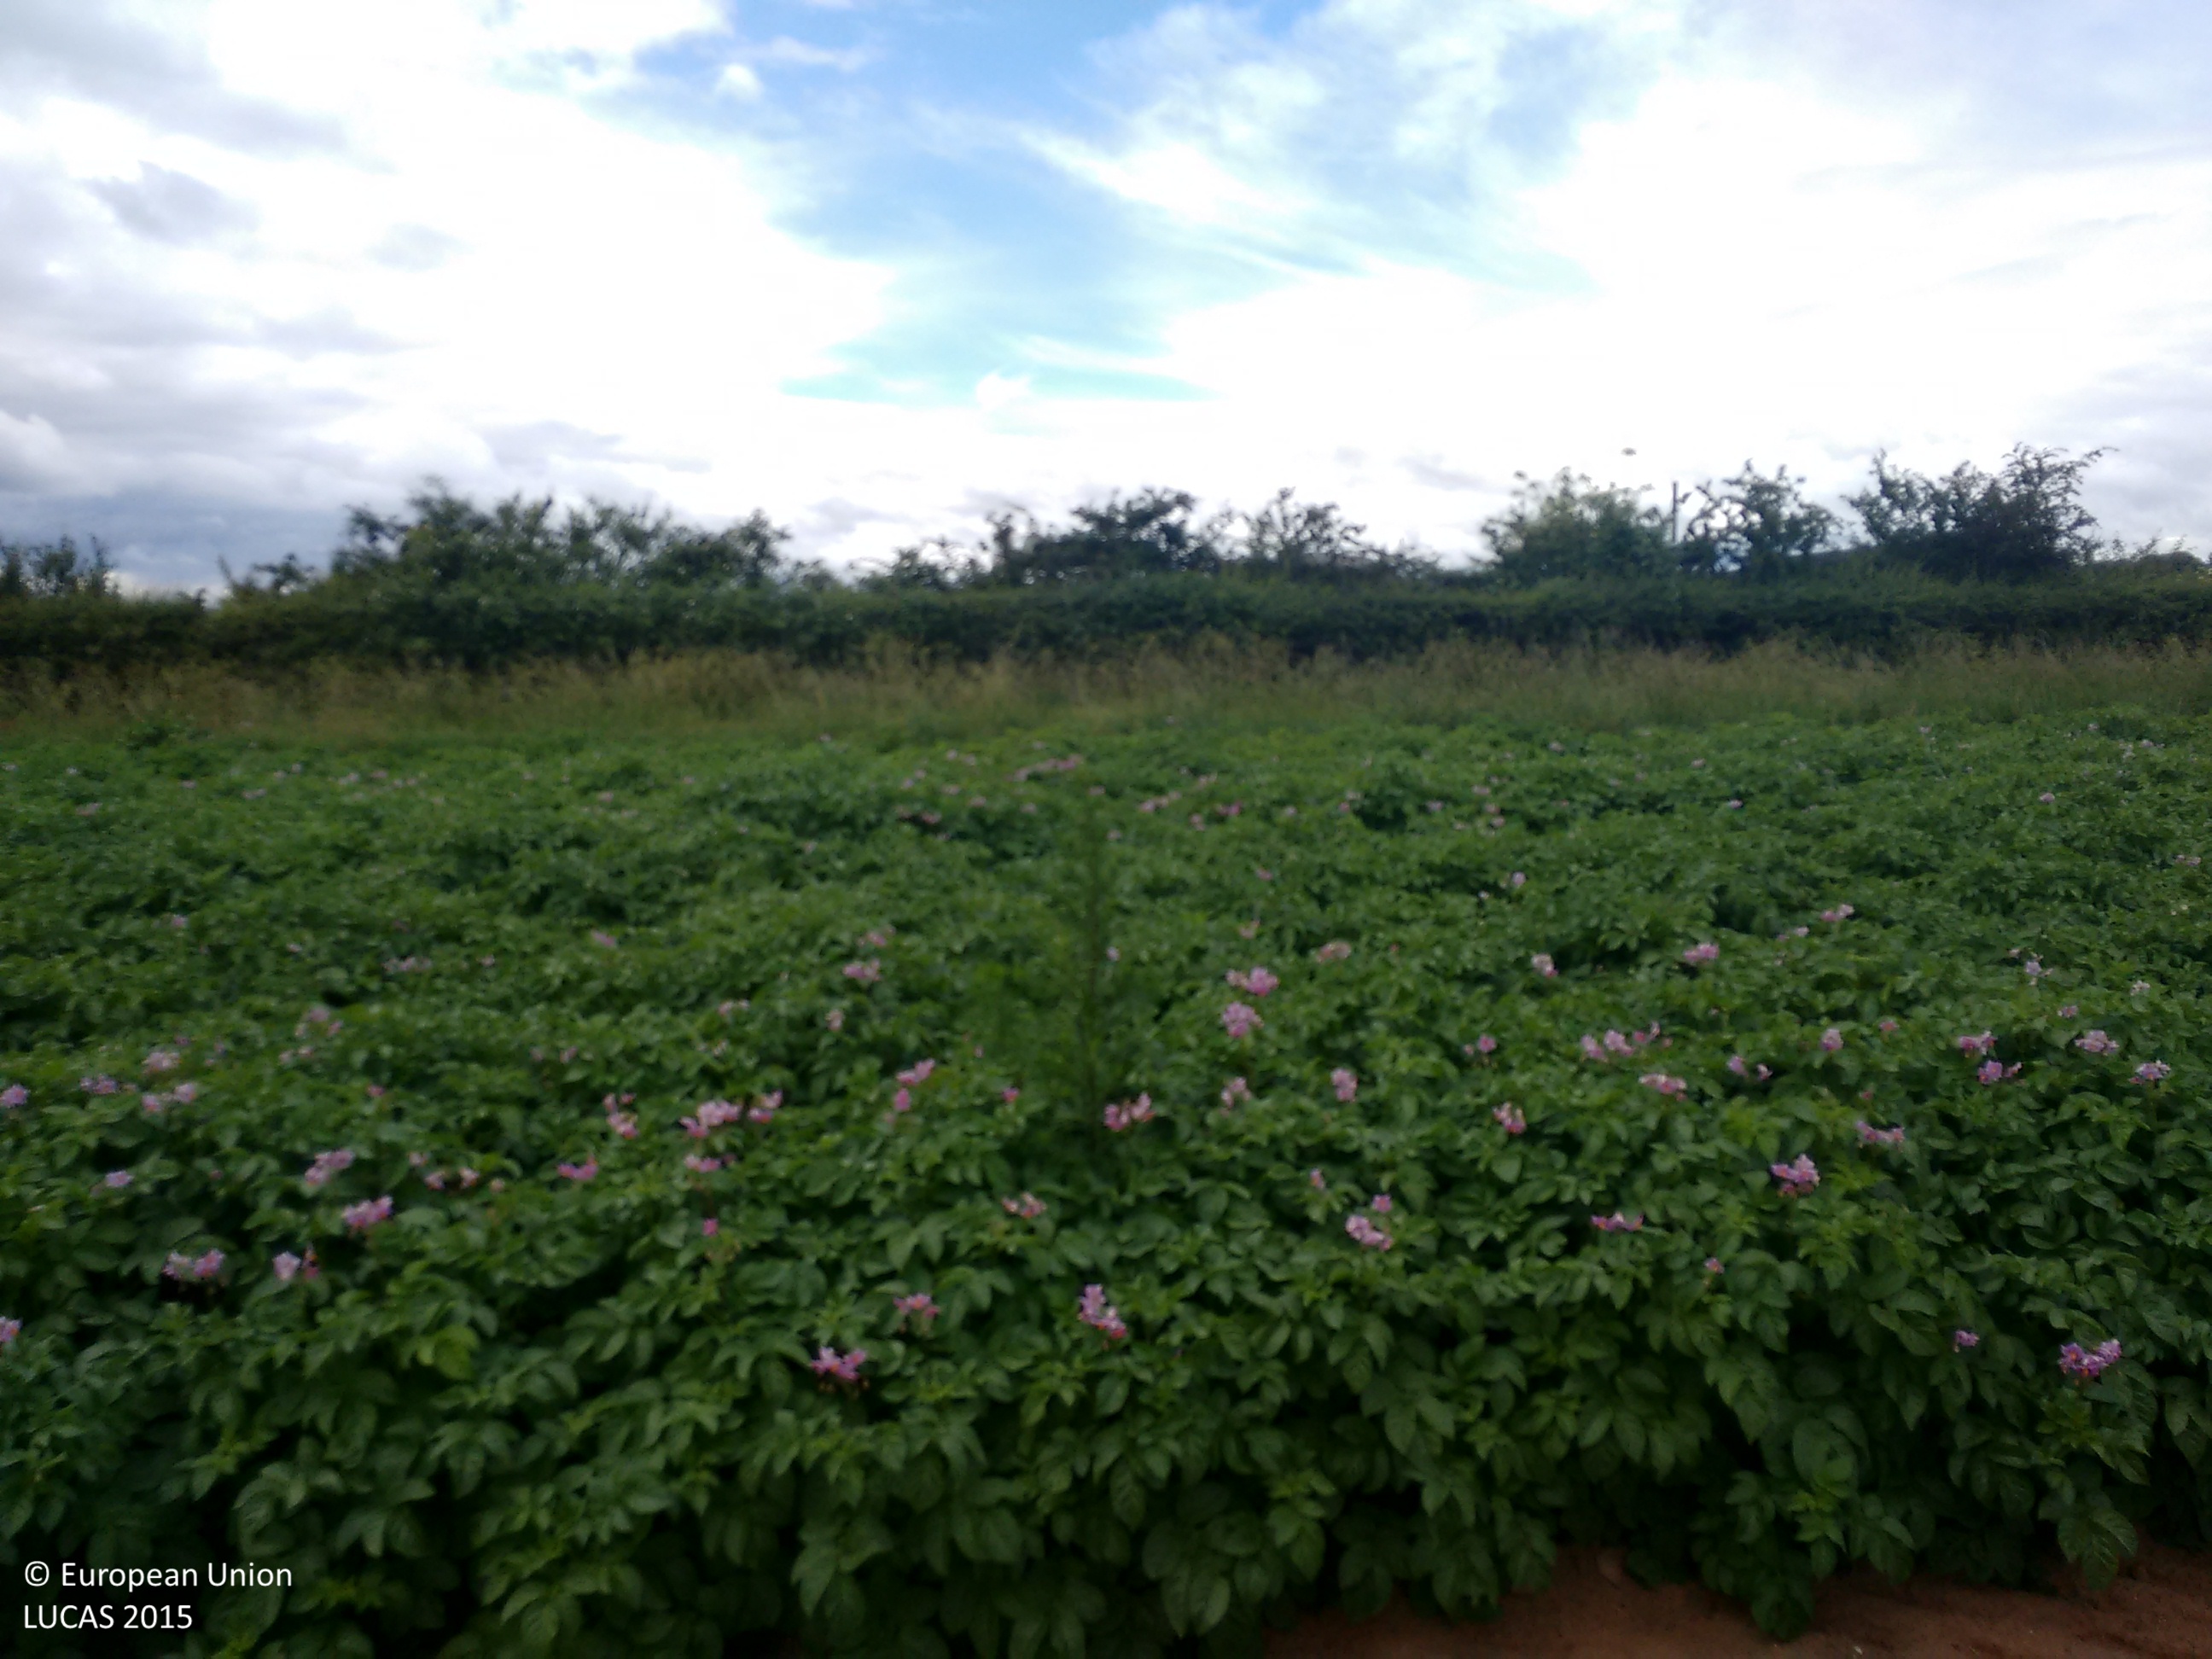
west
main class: Cropland
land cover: Potatoes
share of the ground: > 75 %
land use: Agriculture (excluding fallow land and kitchen gardens)
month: June
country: GB
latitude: 53.7611
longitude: -1.1024
